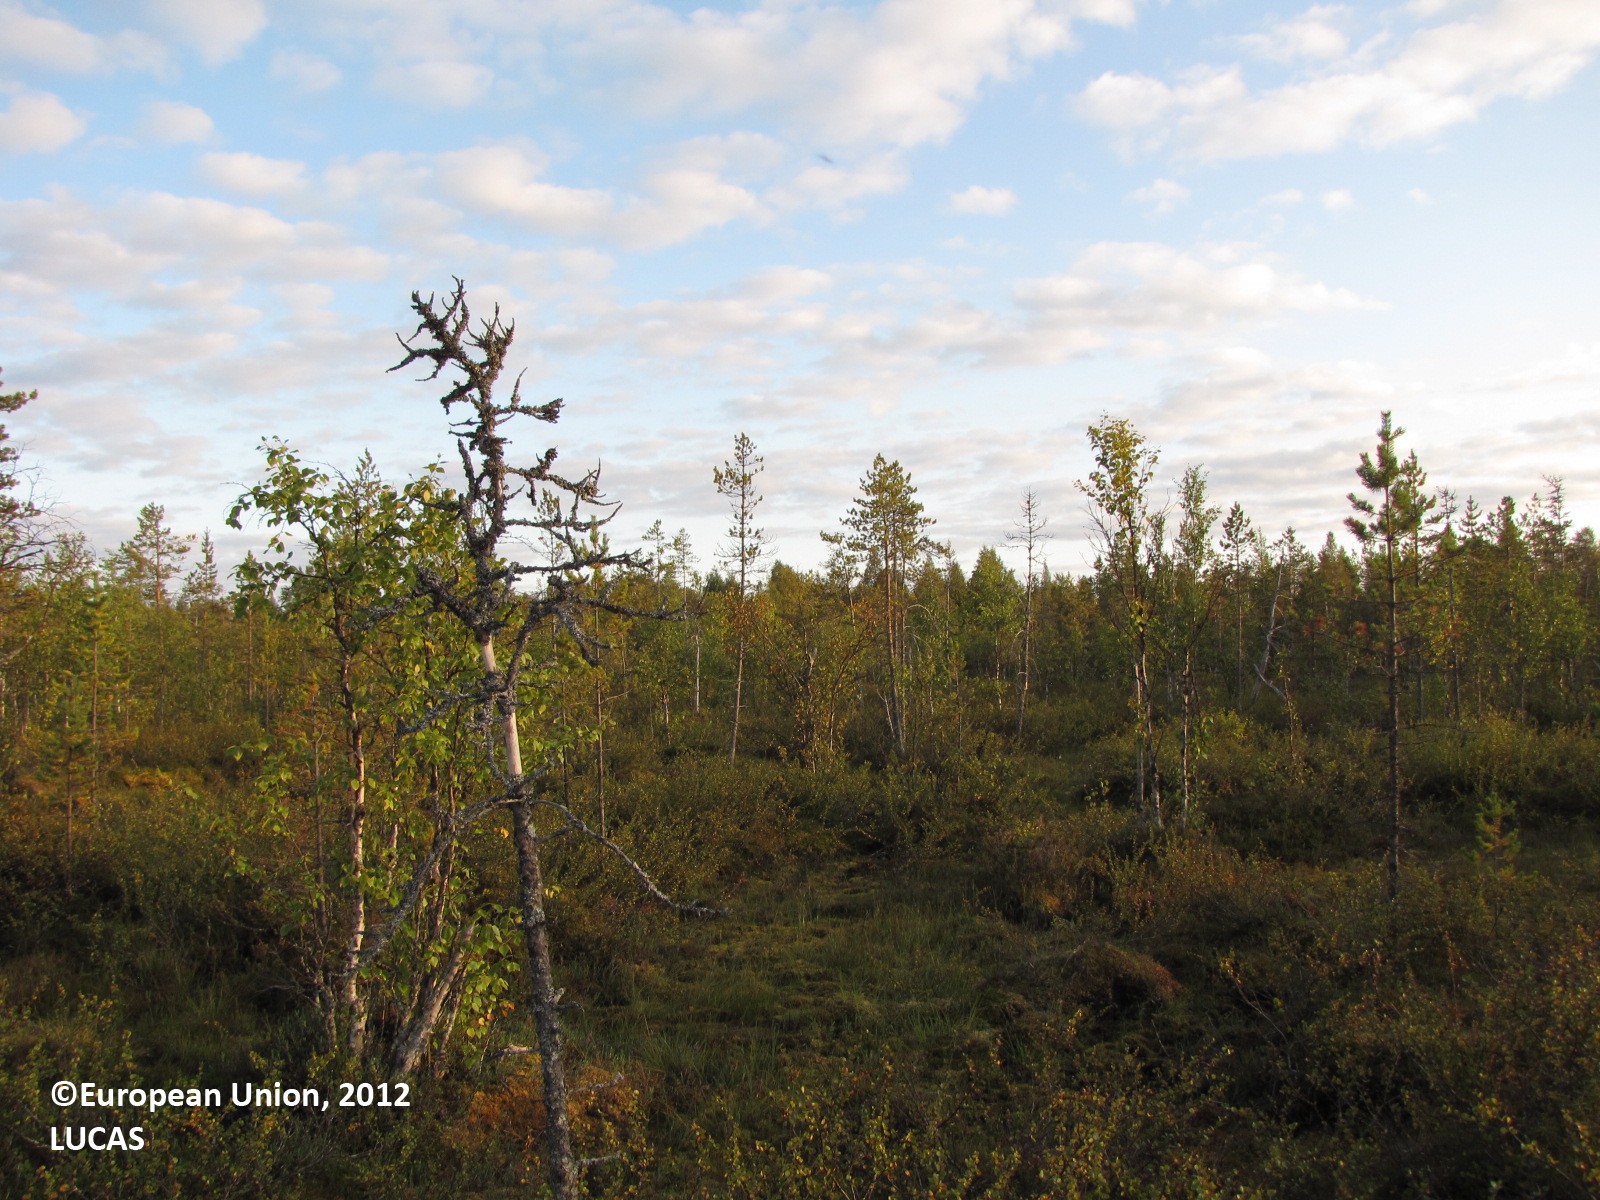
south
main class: Woodland
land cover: Pine dominated mixed woodland
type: boreal forest
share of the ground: 10 - 25 %
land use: Forestry
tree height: > 5 m
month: August
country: FI
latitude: 67.0580
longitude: 25.0591
